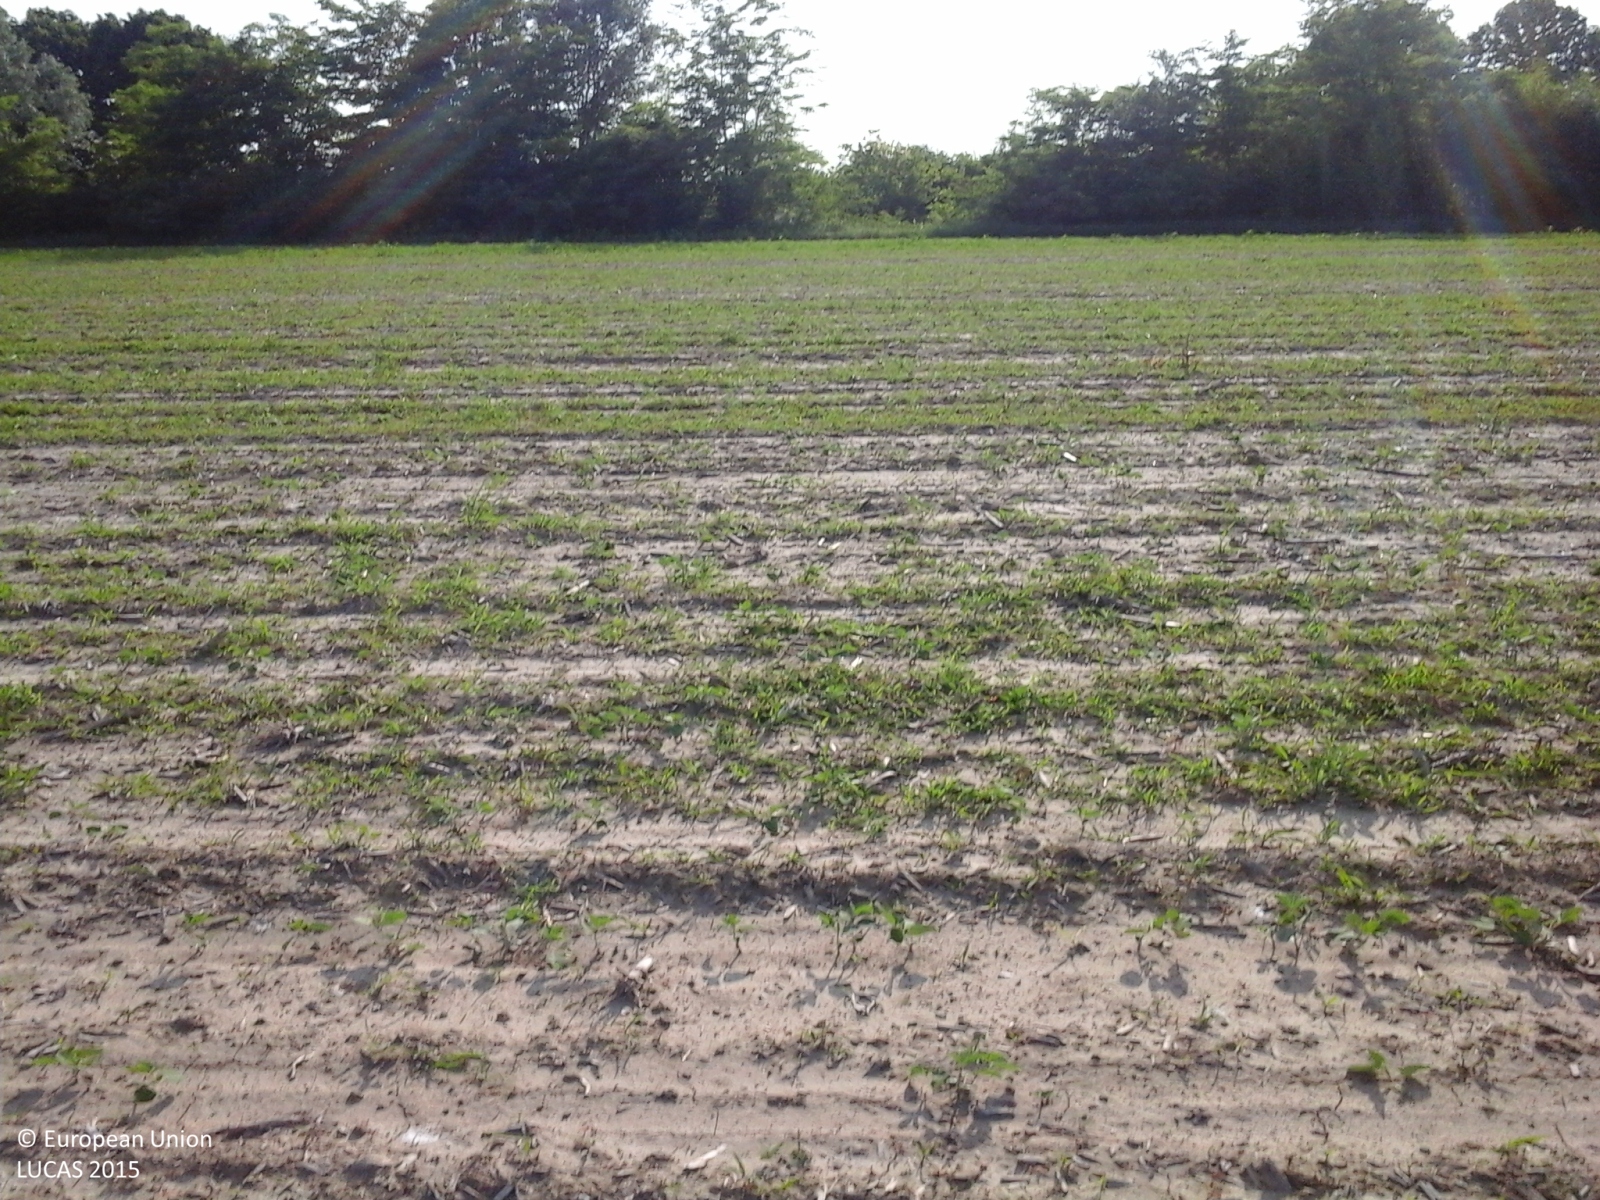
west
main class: Cropland
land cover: Soya
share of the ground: < 10 %
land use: Agriculture (excluding fallow land and kitchen gardens)
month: June
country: IT
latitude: 45.7961
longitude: 12.6338
